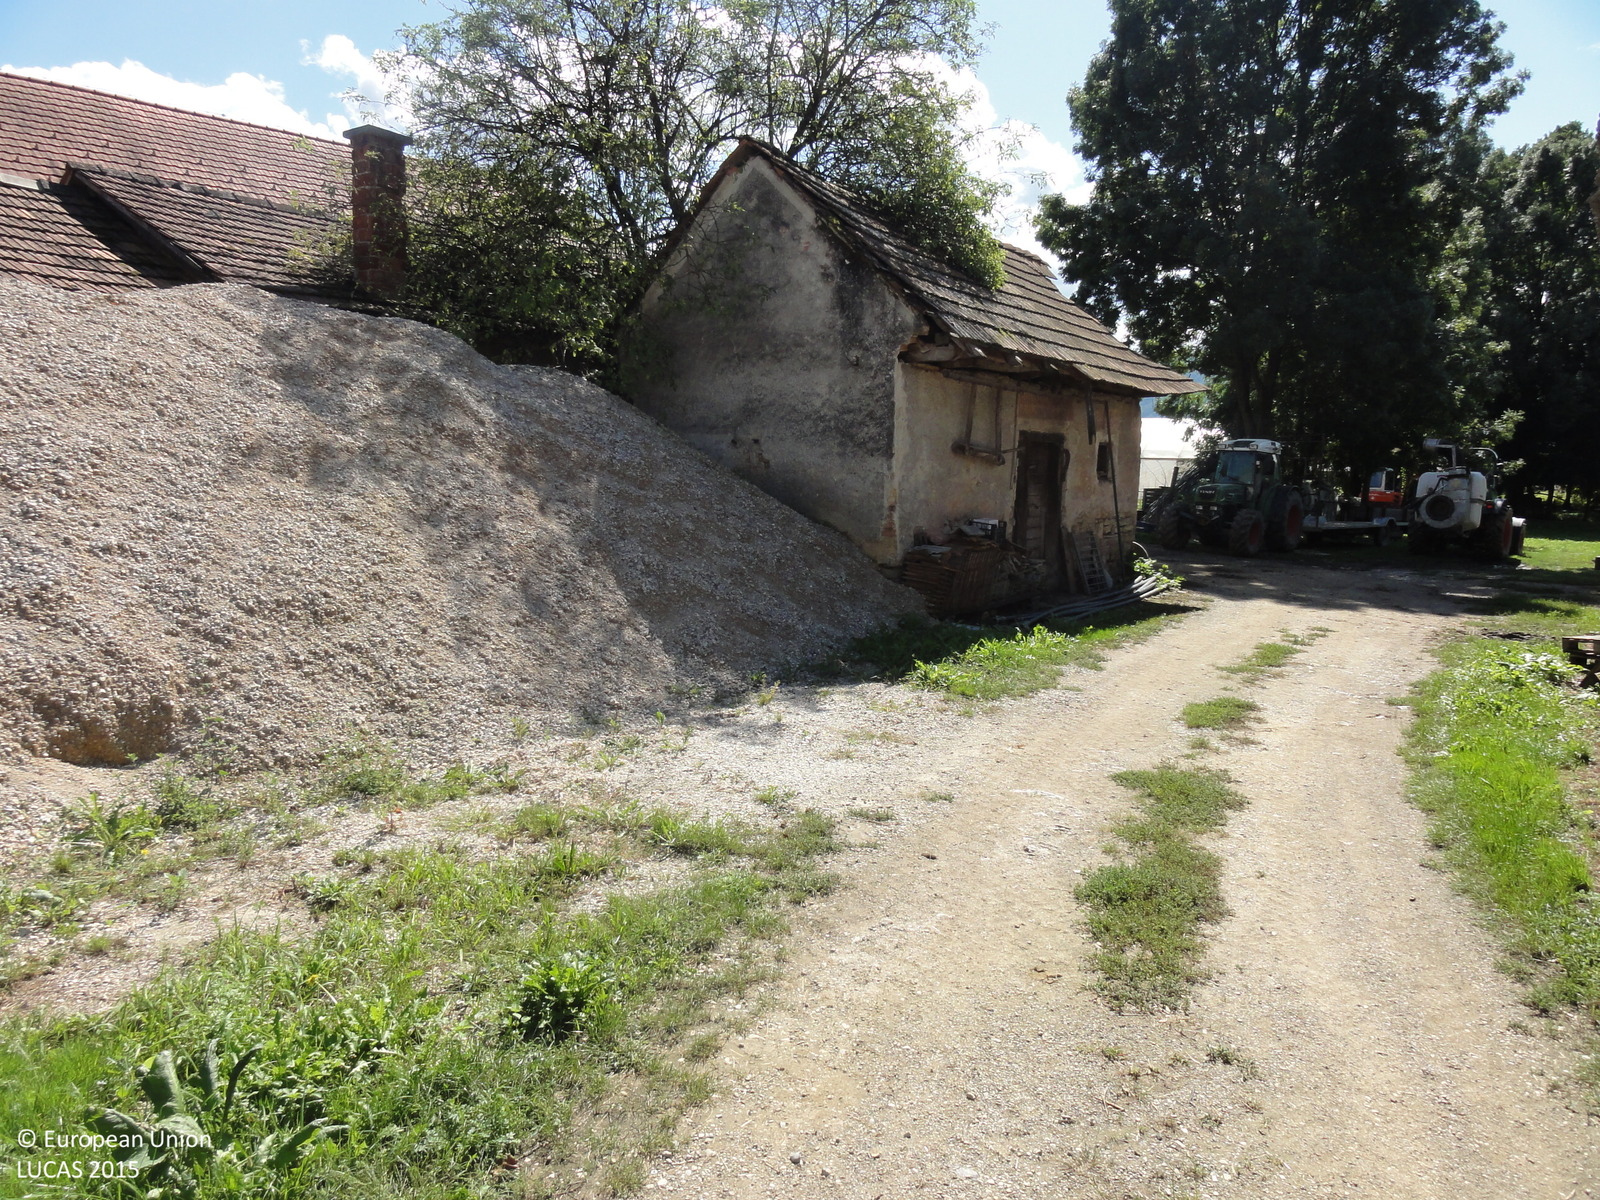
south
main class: Grassland
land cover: Grassland without tree/shrub cover
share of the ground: > 75 %
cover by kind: herbaceous plants 100 %
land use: Residential
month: September
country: SI
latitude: 45.8695
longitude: 15.4462
